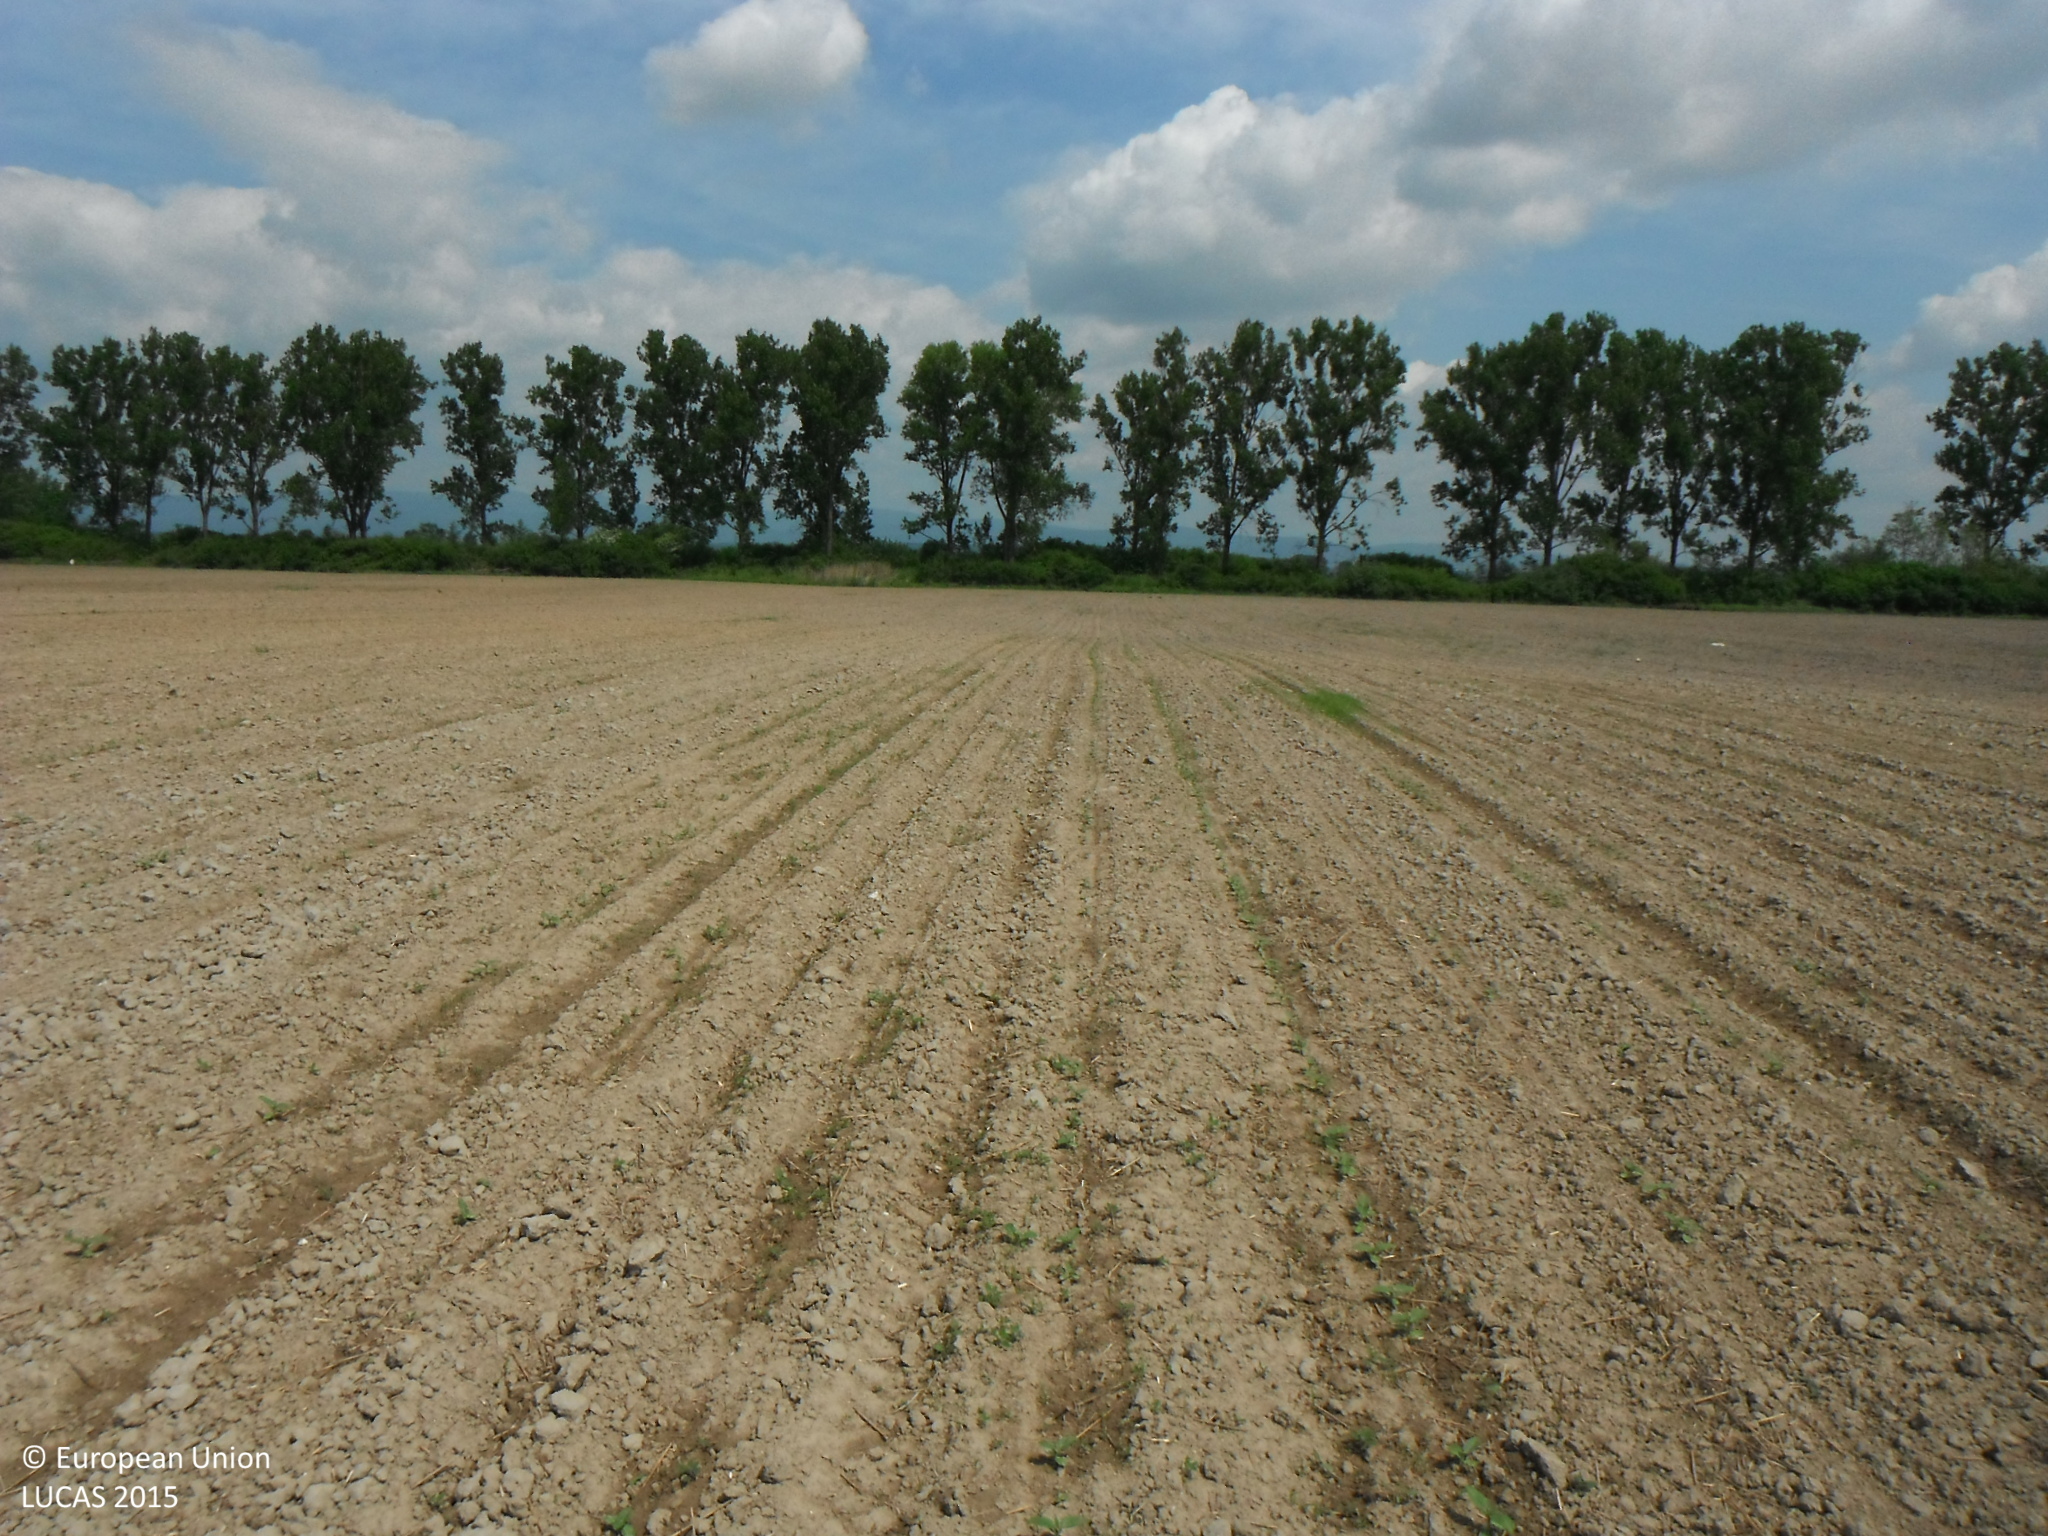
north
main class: Cropland
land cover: Sunflower
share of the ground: < 10 %
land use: Agriculture (excluding fallow land and kitchen gardens)
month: May
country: SK
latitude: 48.5581
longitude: 21.0296
